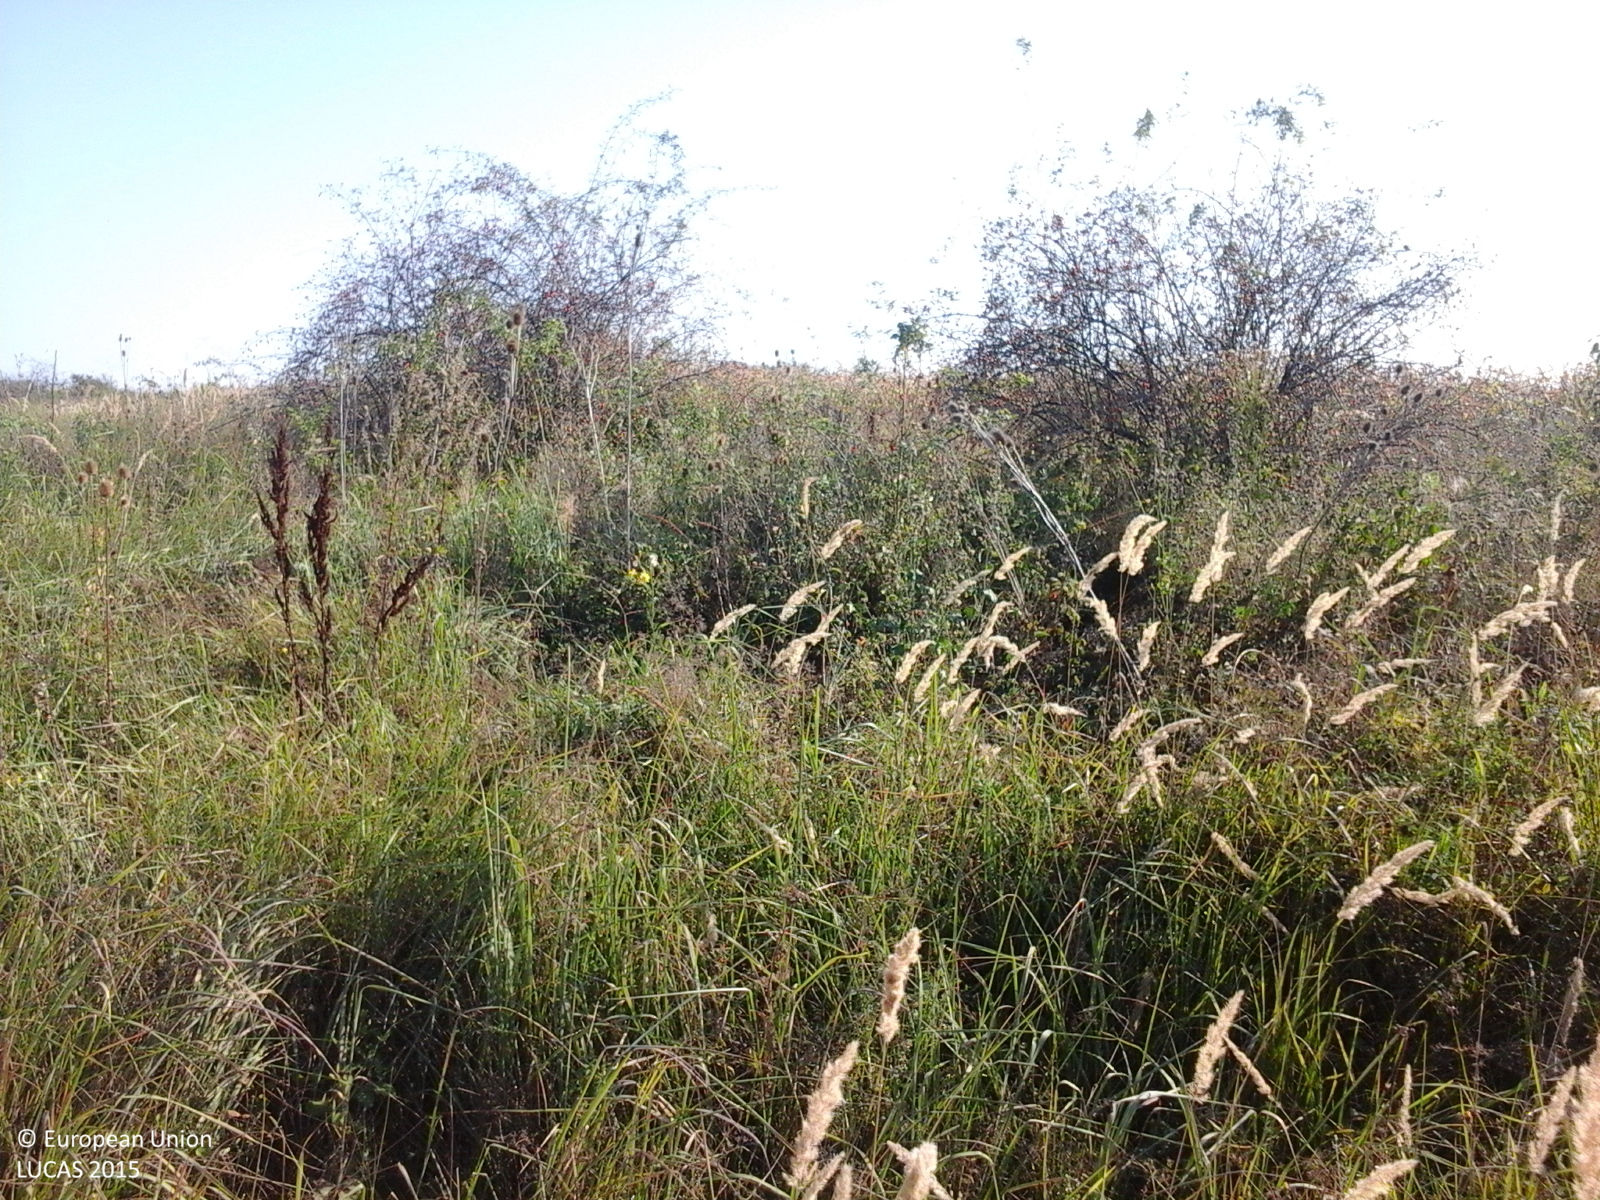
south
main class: Grassland
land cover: Spontaneously vegetated surfaces
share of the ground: > 75 %
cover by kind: herbaceous plants 100 %
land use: Fallow land
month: September
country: RO
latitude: 47.3733
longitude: 23.0302
